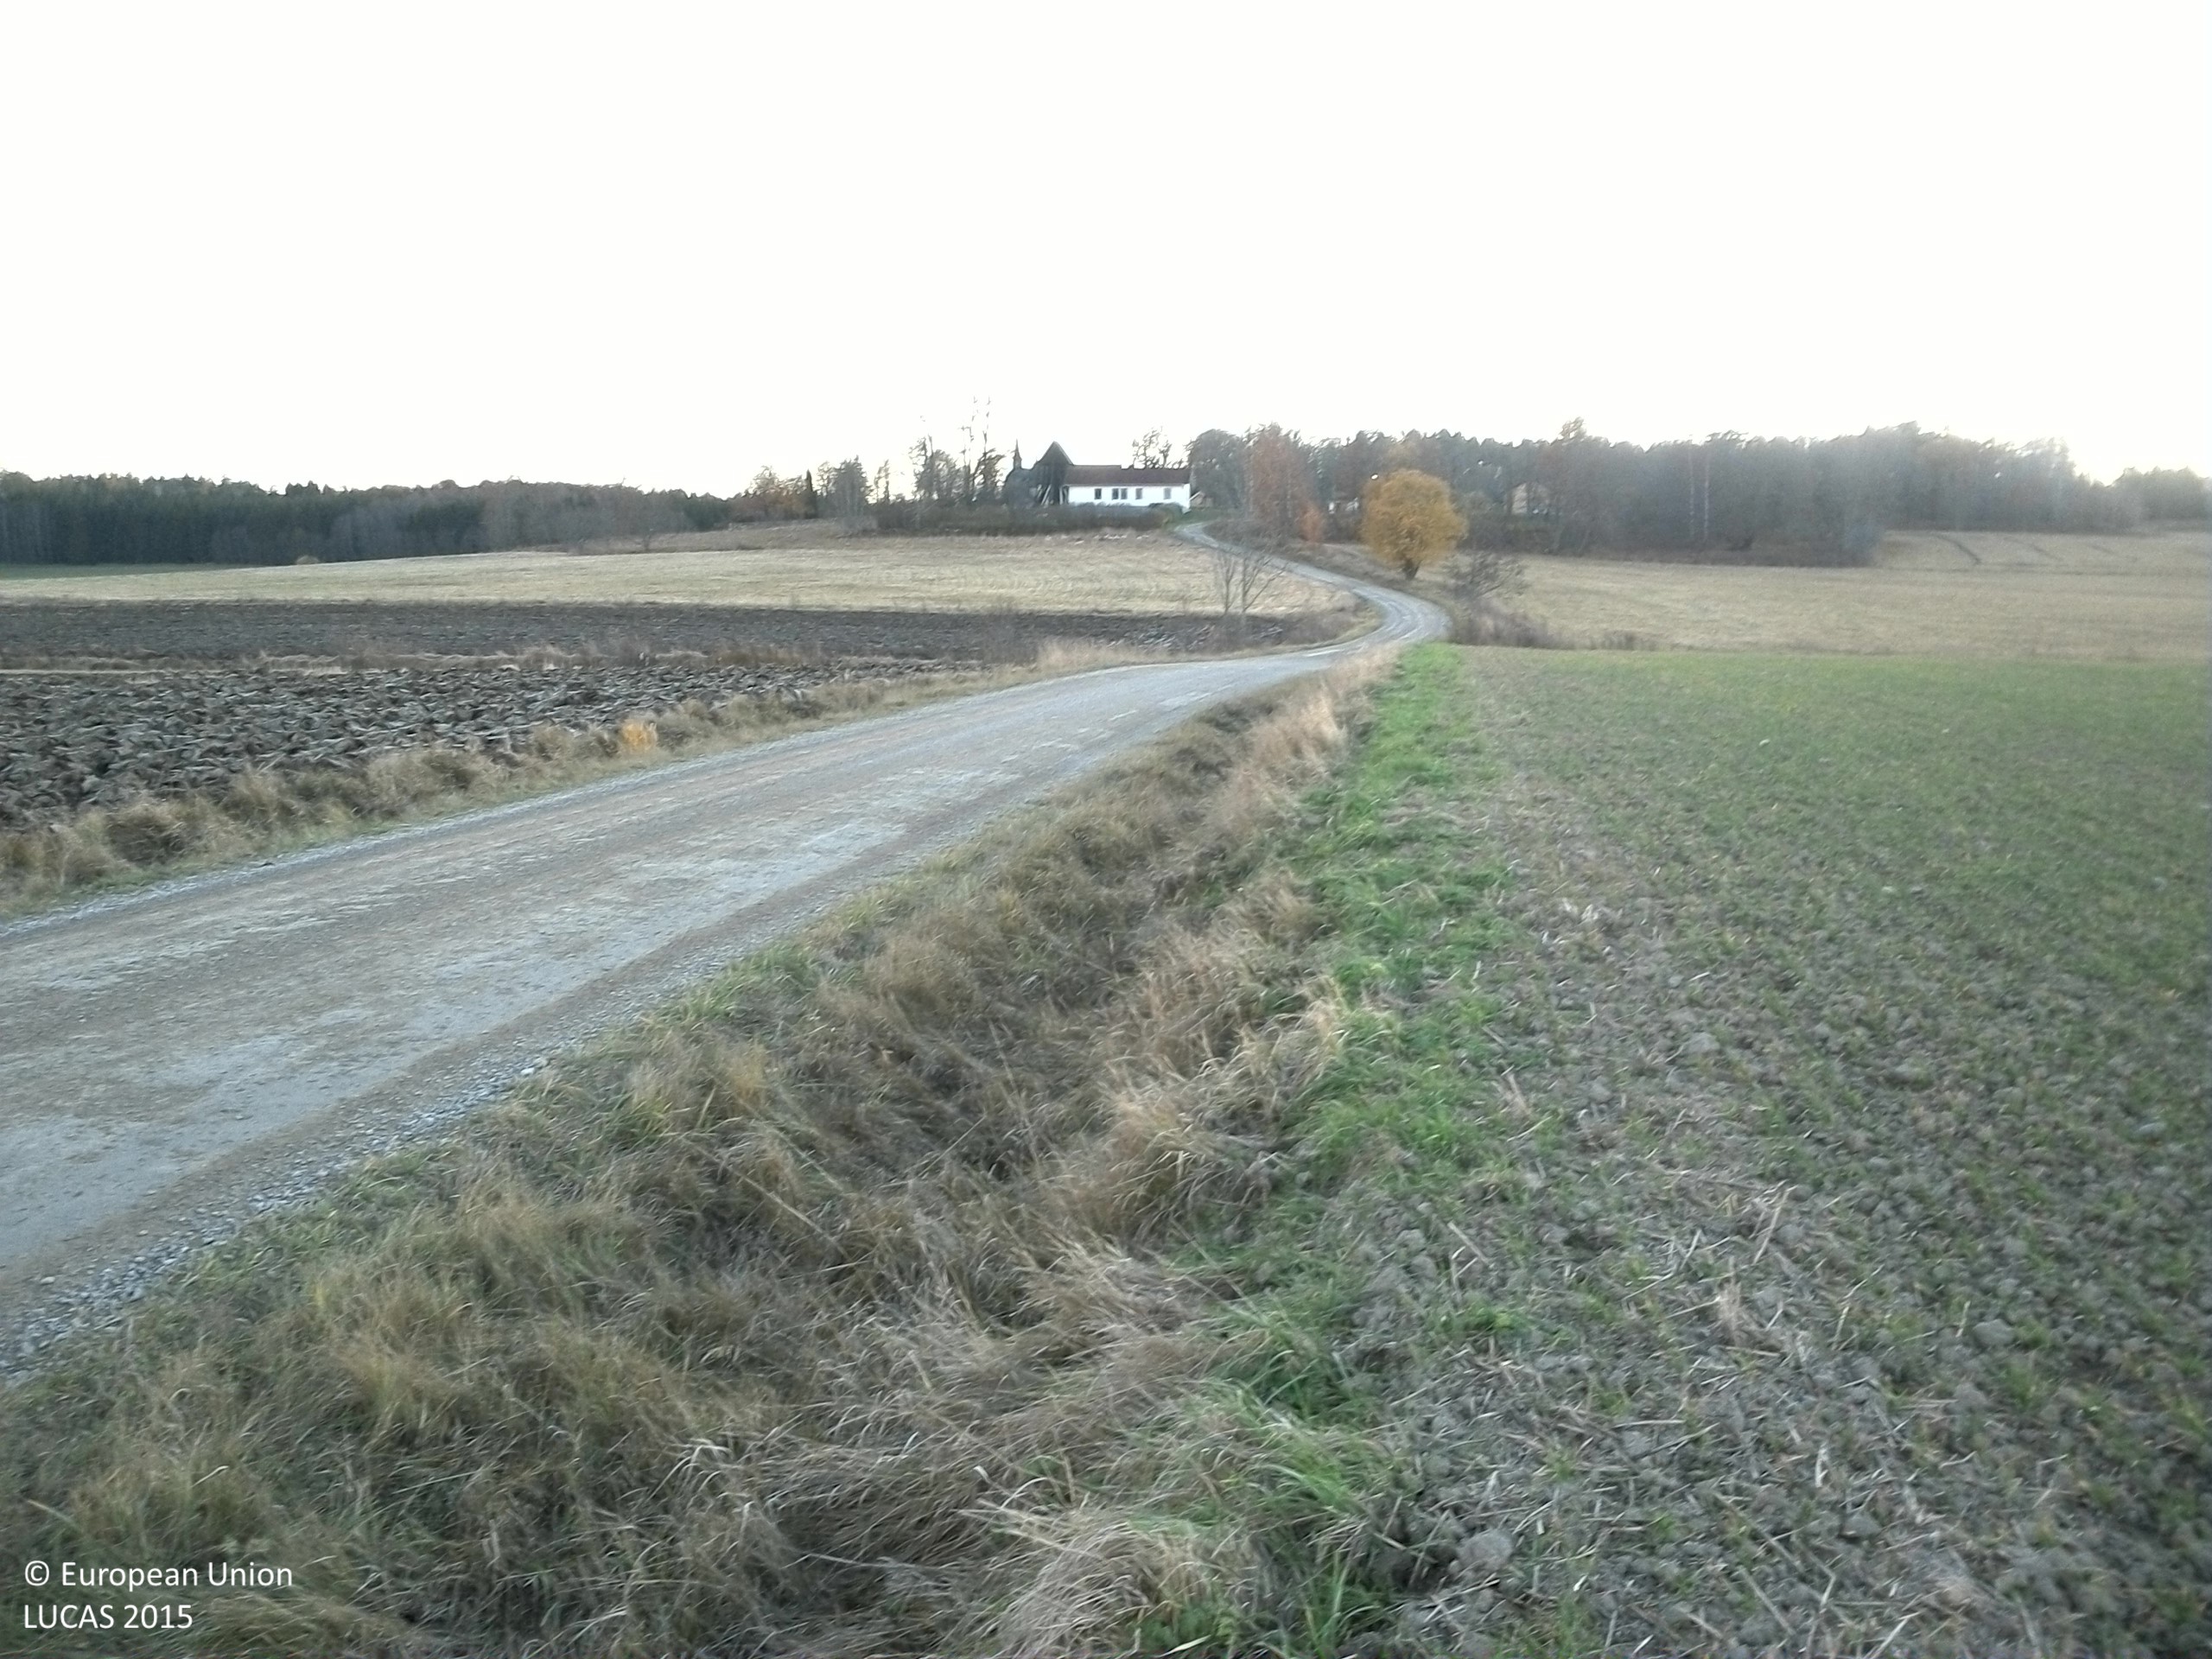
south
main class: Cropland
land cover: Common wheat
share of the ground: > 75 %
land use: Agriculture (excluding fallow land and kitchen gardens)
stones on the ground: < 10 %
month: November
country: SE
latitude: 58.8383
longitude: 16.8745
